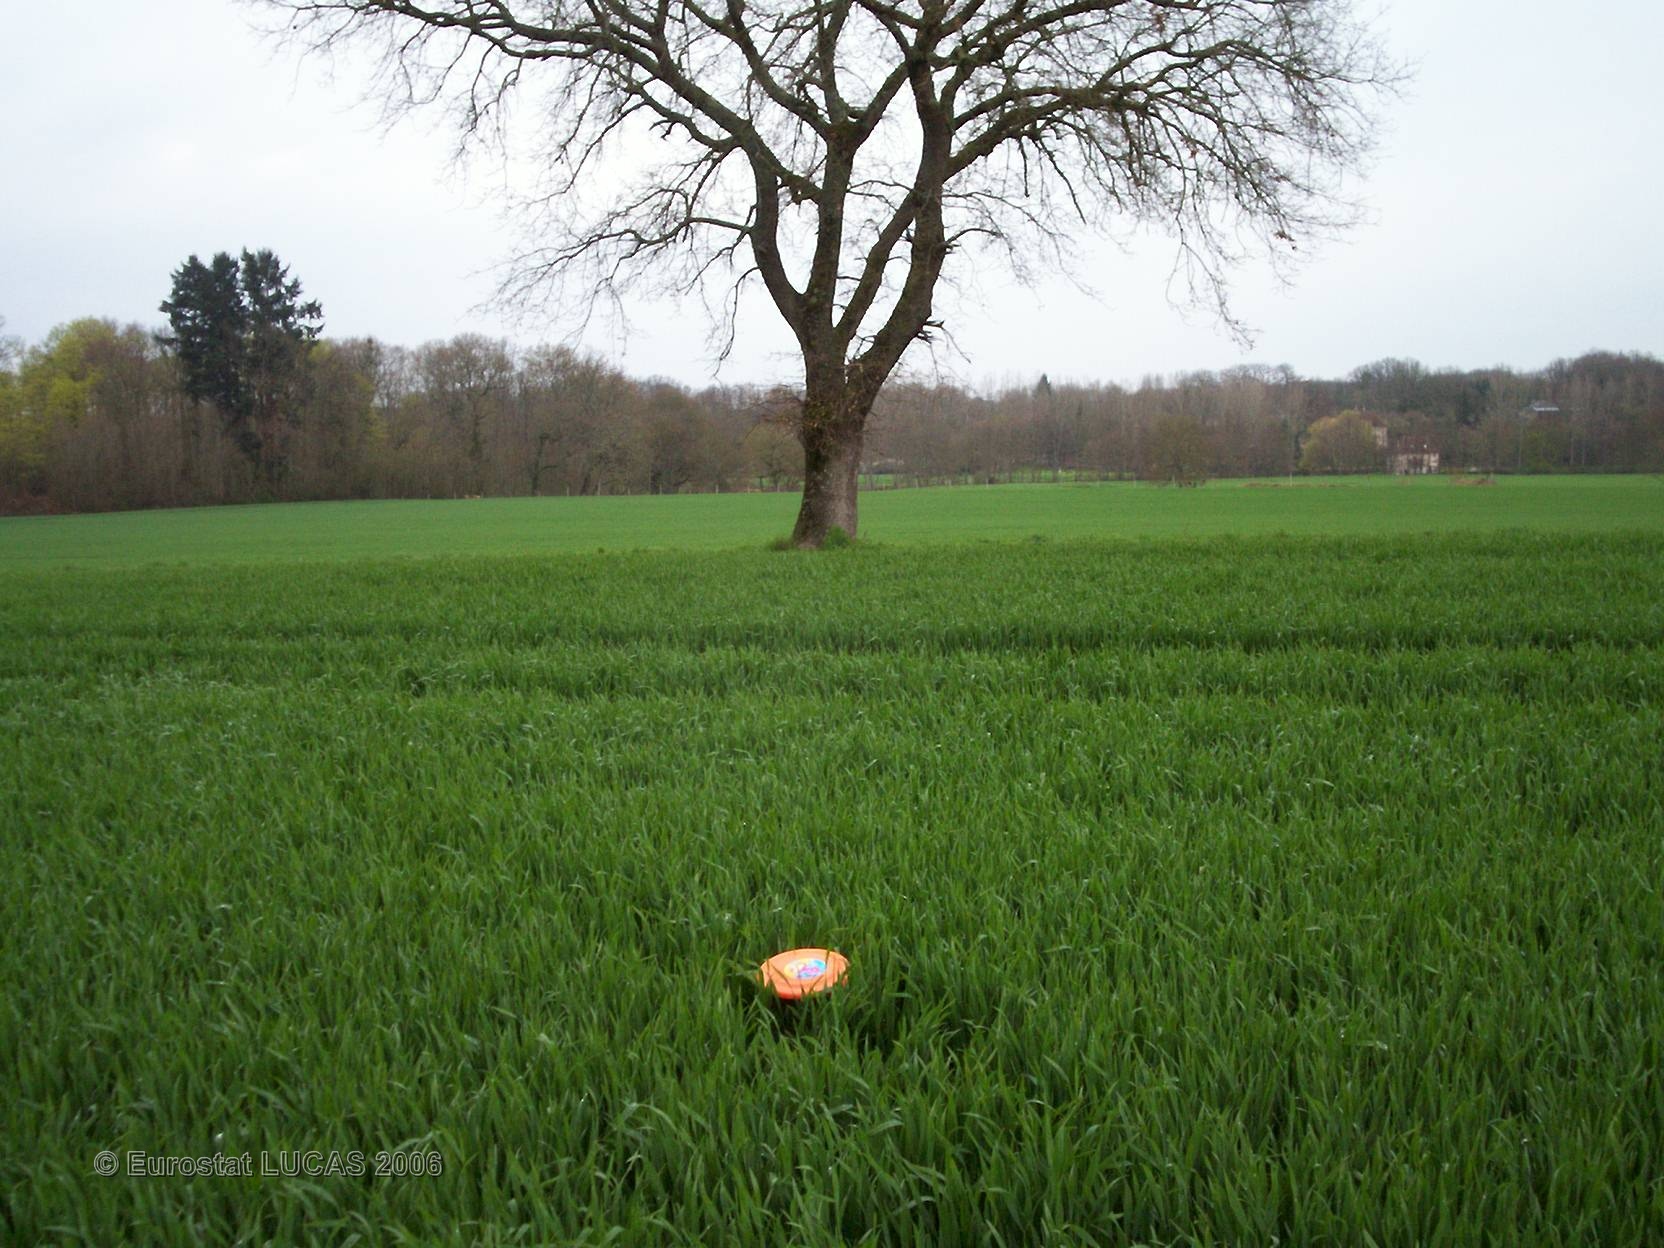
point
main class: Cropland
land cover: Common wheat
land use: Agriculture (excluding fallow land and kitchen gardens)
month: April
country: FR
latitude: 46.5910
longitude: 1.0457
